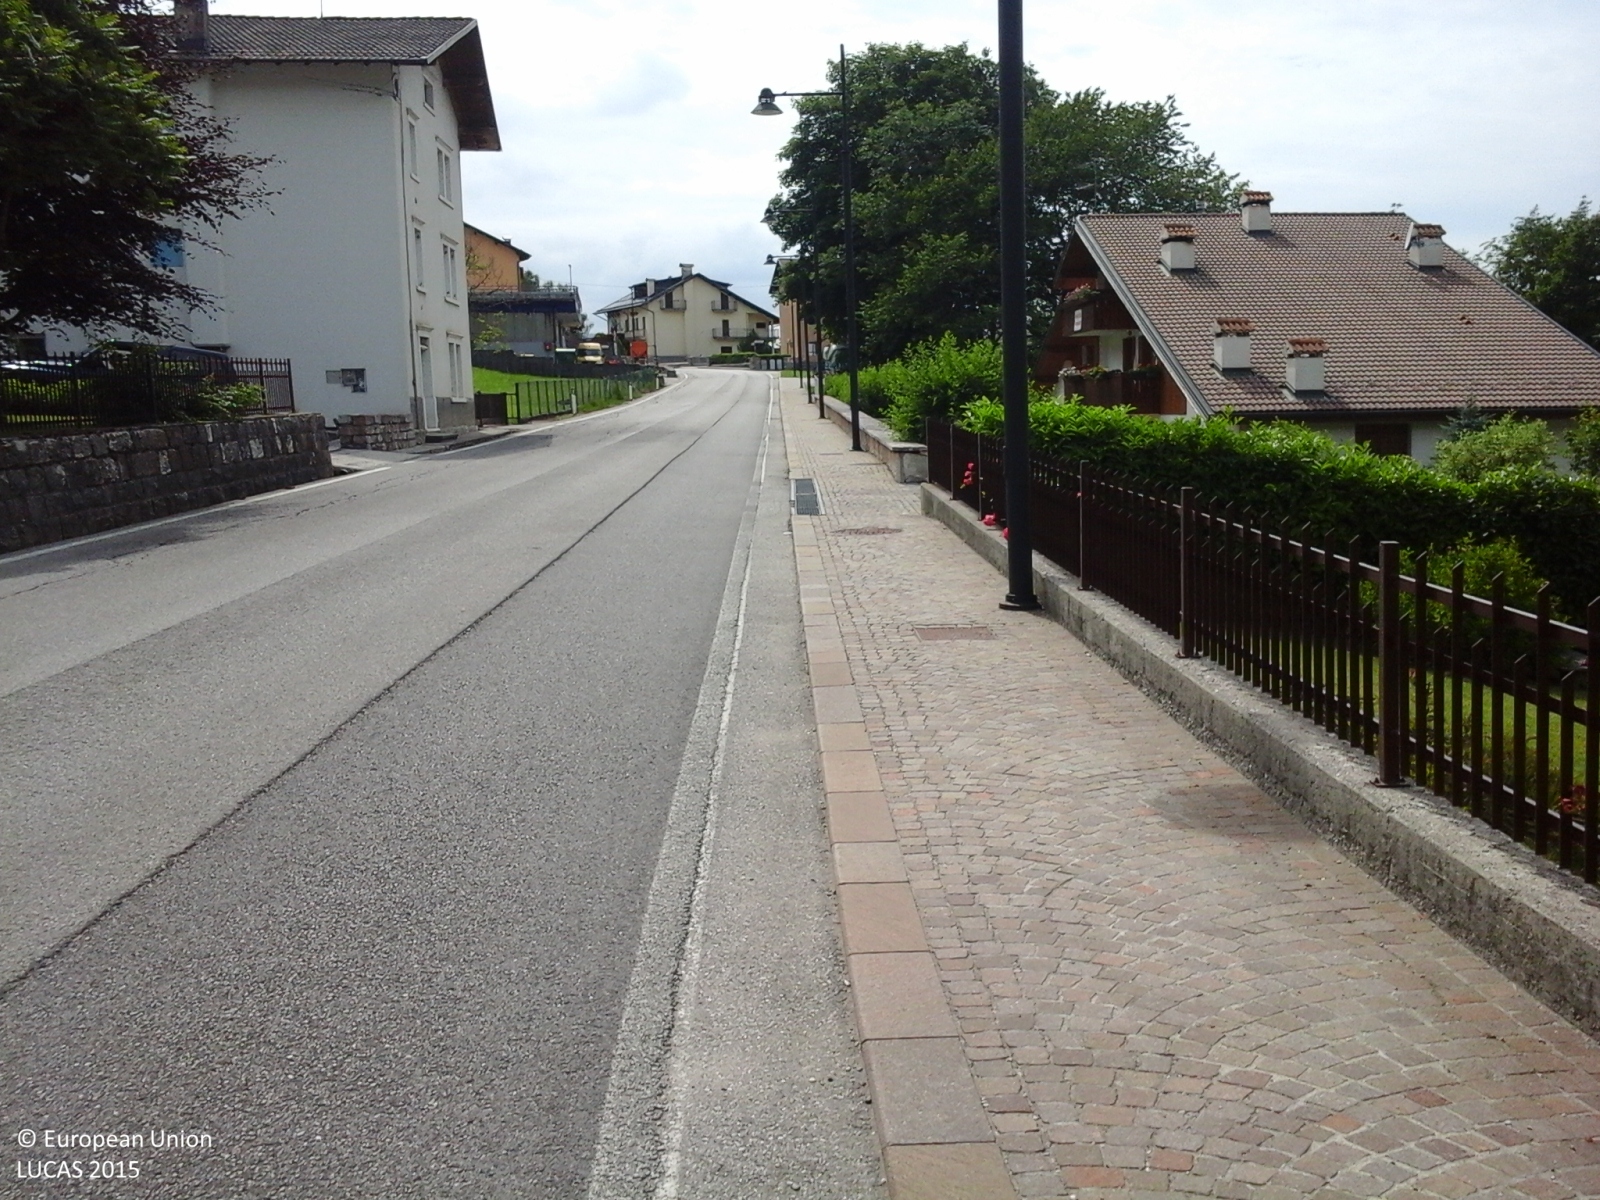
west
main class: Grassland
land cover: Grassland with sparse tree/shrub cover
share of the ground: > 75 %
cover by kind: herbaceous plants 95 %, broadleaved forest trees 5 %
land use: Residential
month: June
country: IT
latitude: 46.1257
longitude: 12.4171
